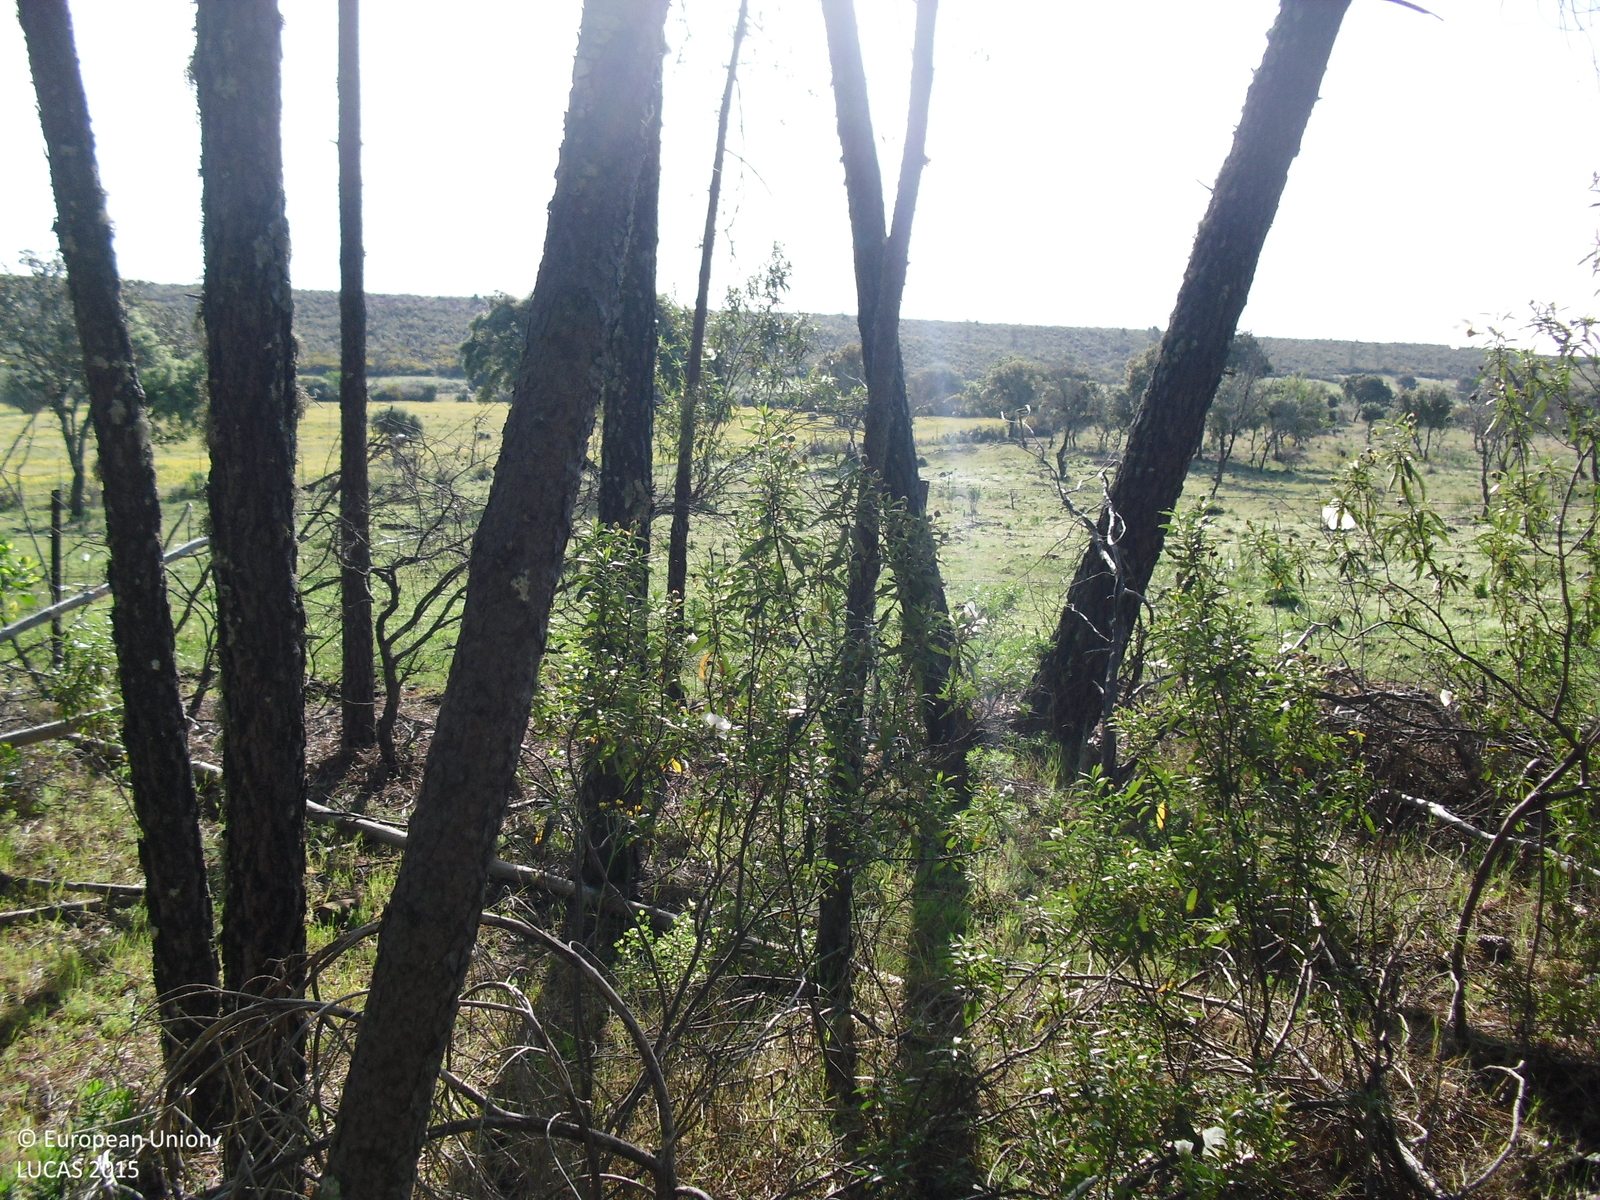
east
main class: Woodland
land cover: Pine dominated coniferous woodland
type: coniferous forest of the mediterranean region
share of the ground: > 75 %
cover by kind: coniferous forest trees 90 %, herbaceous plants 10 %
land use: Forestry
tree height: > 5 m
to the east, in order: Pine dominated coniferous woodland; Fences; Grassland with sparse tree/shrub cover; Fences; Other structural elements; Other leguminous and mixtures for fodder; Shruby margins; Fences; Olive groves
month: April
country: ES
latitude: 40.0574
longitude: -6.8161
